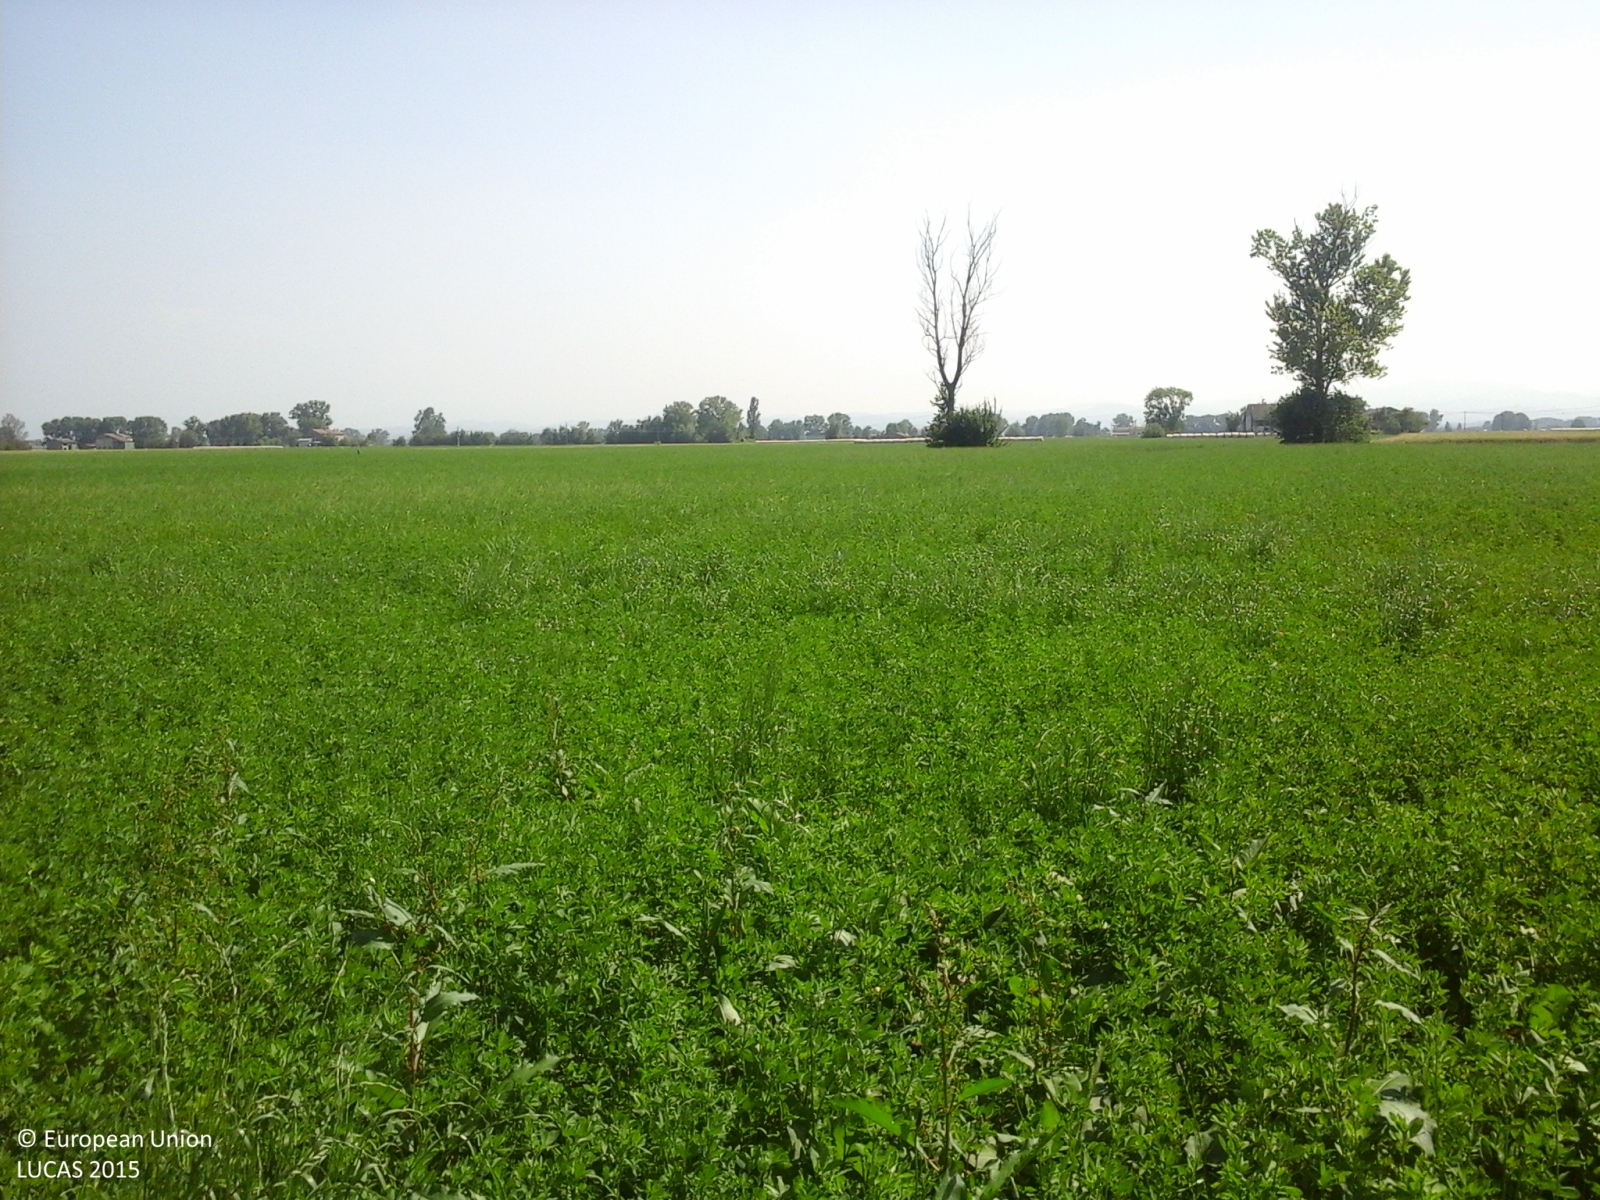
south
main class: Cropland
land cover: Lucerne
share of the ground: > 75 %
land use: Agriculture (excluding fallow land and kitchen gardens)
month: June
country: IT
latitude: 44.9276
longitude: 10.0632
